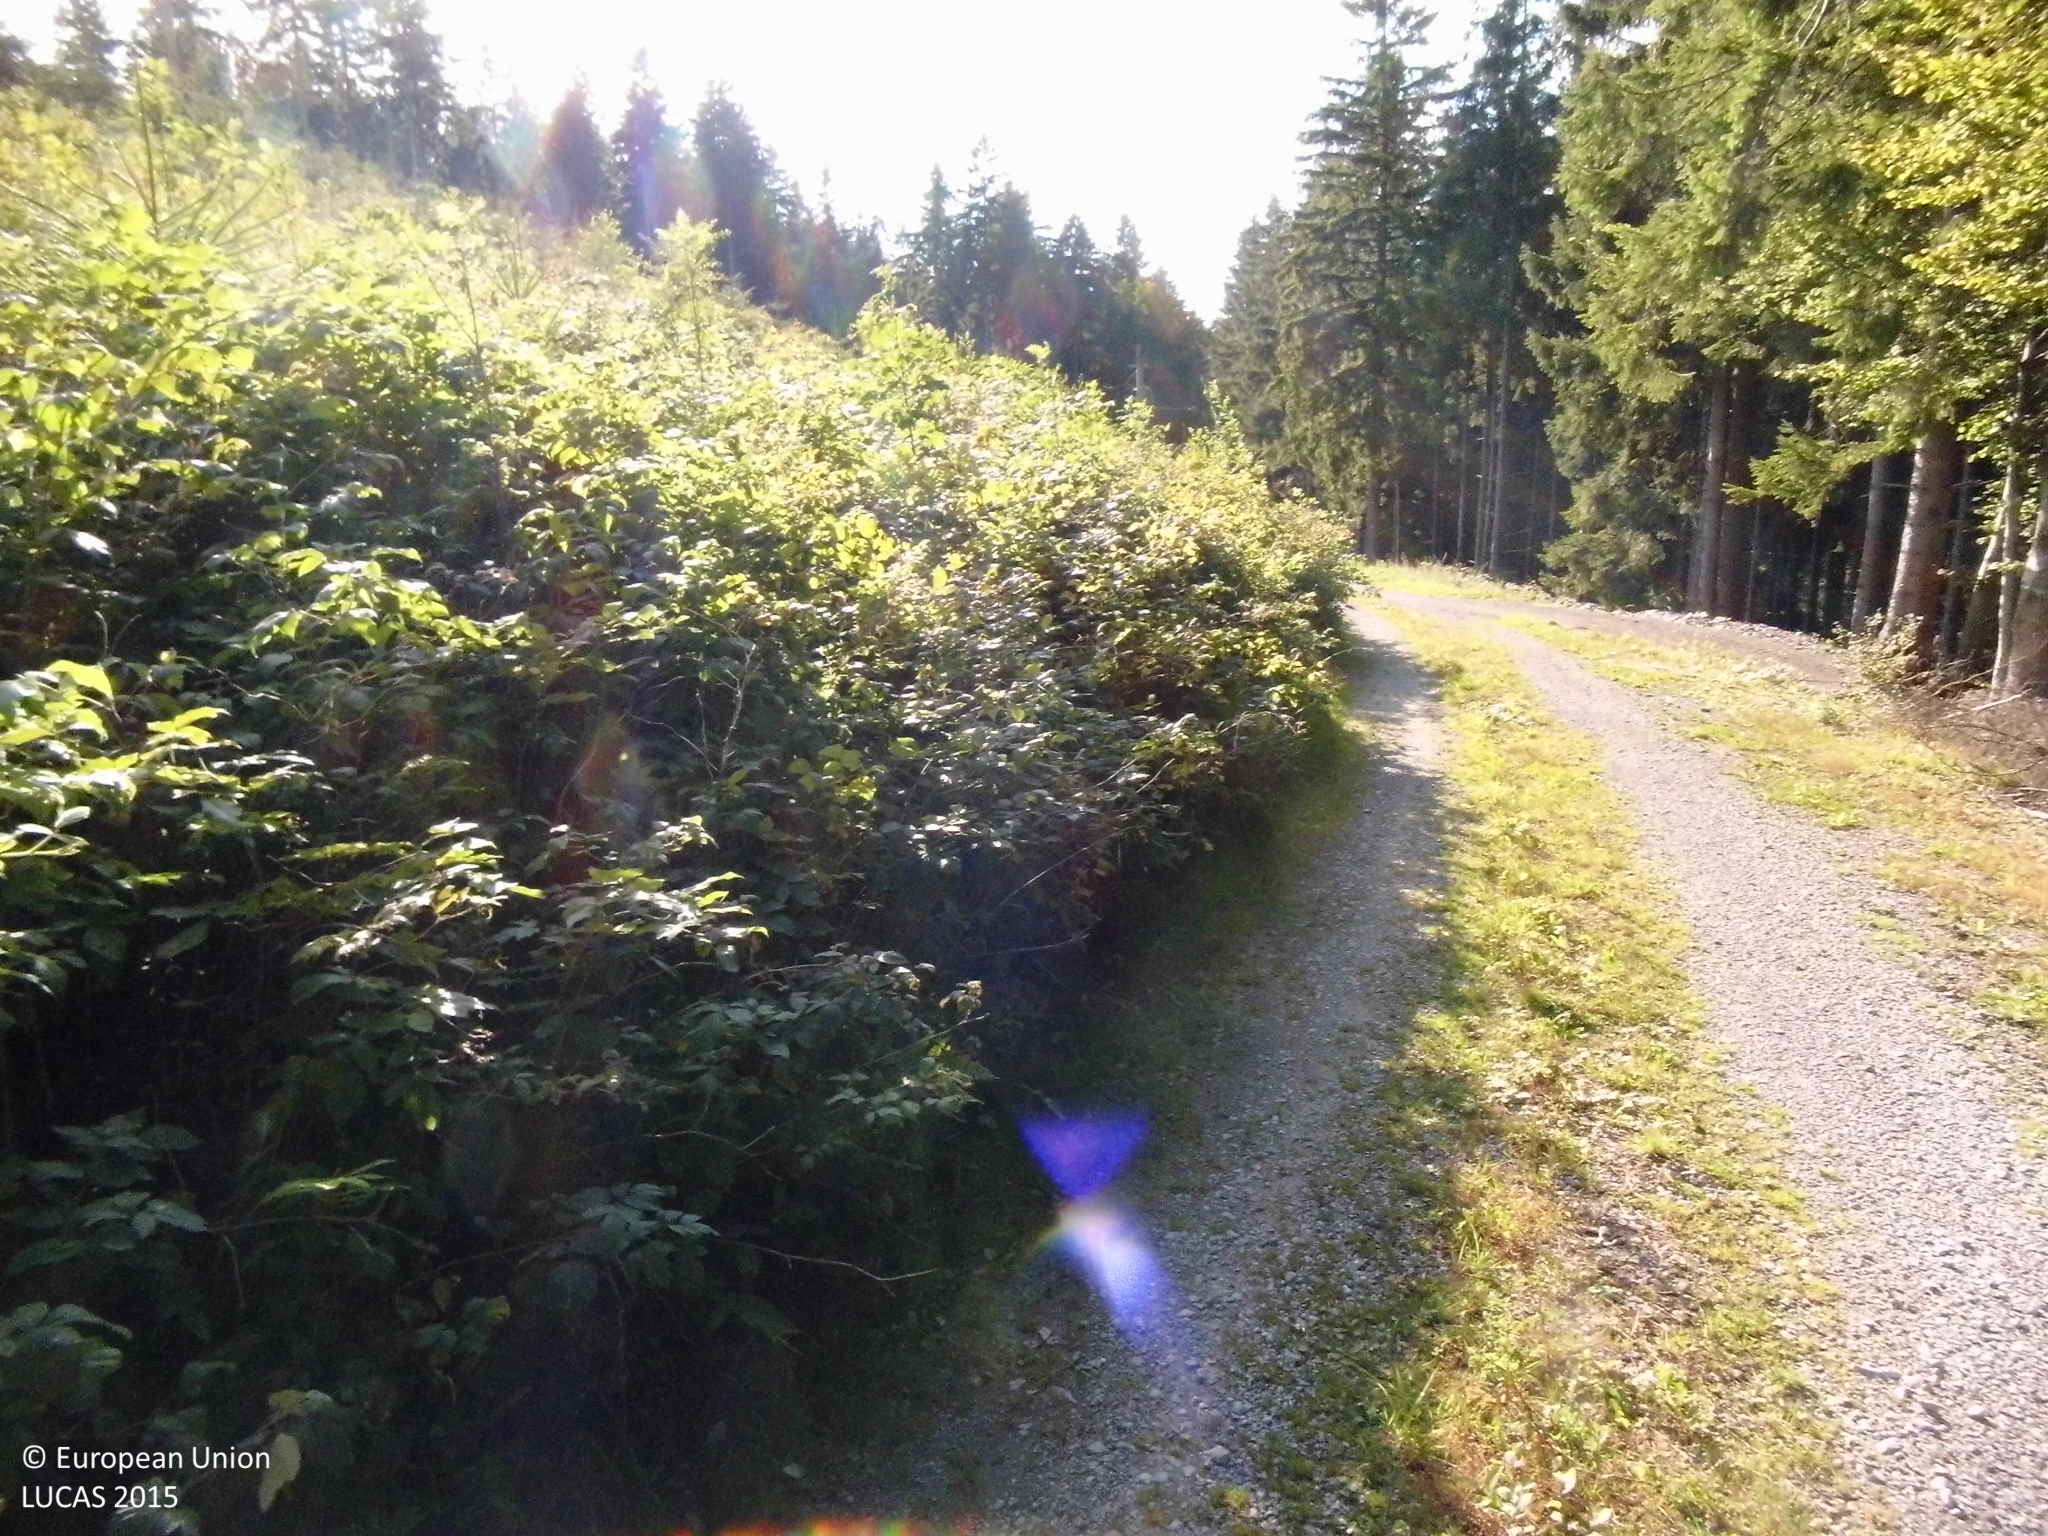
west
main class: Woodland
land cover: Spruce dominated mixed woodland
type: hemiboreal forest and nemoral coniferous forest and mixed broadleaved-coniferous forest
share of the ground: 25 - 50 %
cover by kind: shrubs 50 %, coniferous forest trees 35 %, broadleaved forest trees 15 %
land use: Forestry
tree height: < 5 m
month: September
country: DE
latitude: 51.3083
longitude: 8.5802
